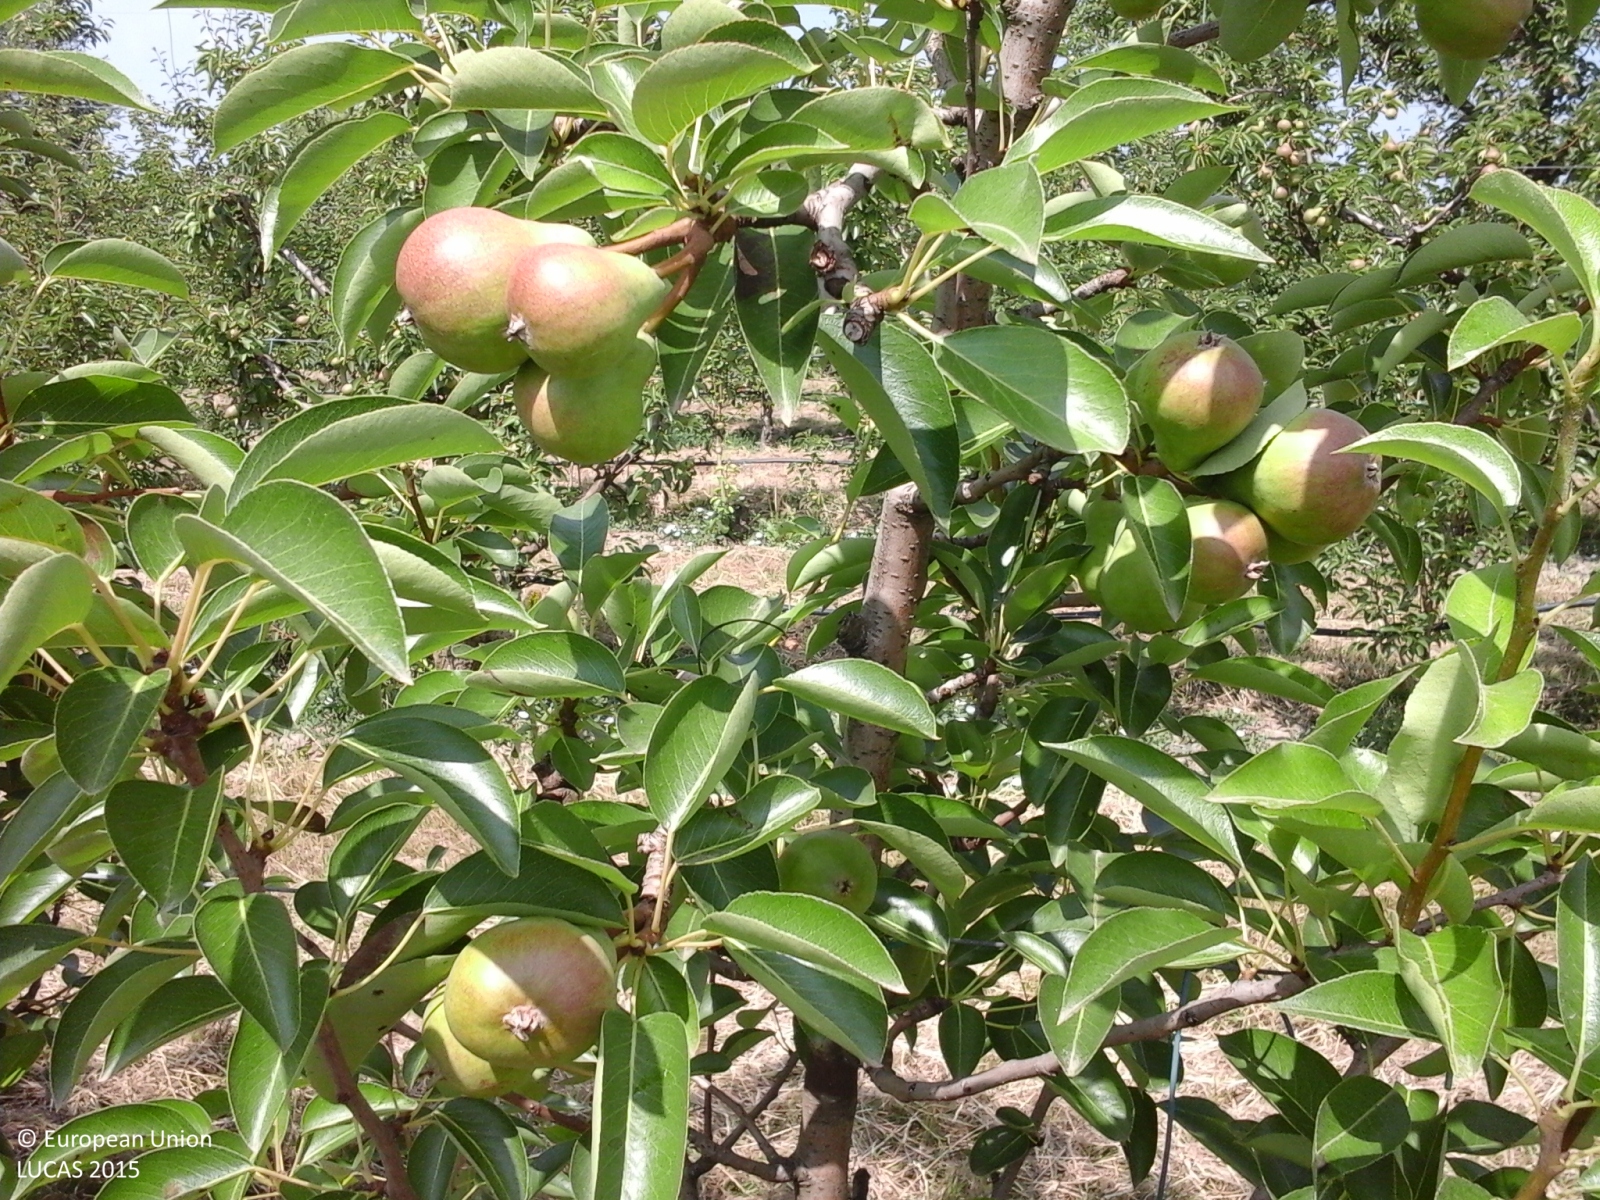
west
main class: Cropland
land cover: Pear fruit
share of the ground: 50 - 75 %
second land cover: Grassland without tree/shrub cover
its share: > 75 %
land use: Agriculture (excluding fallow land and kitchen gardens)
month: June
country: IT
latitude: 44.8494
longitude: 11.1238
